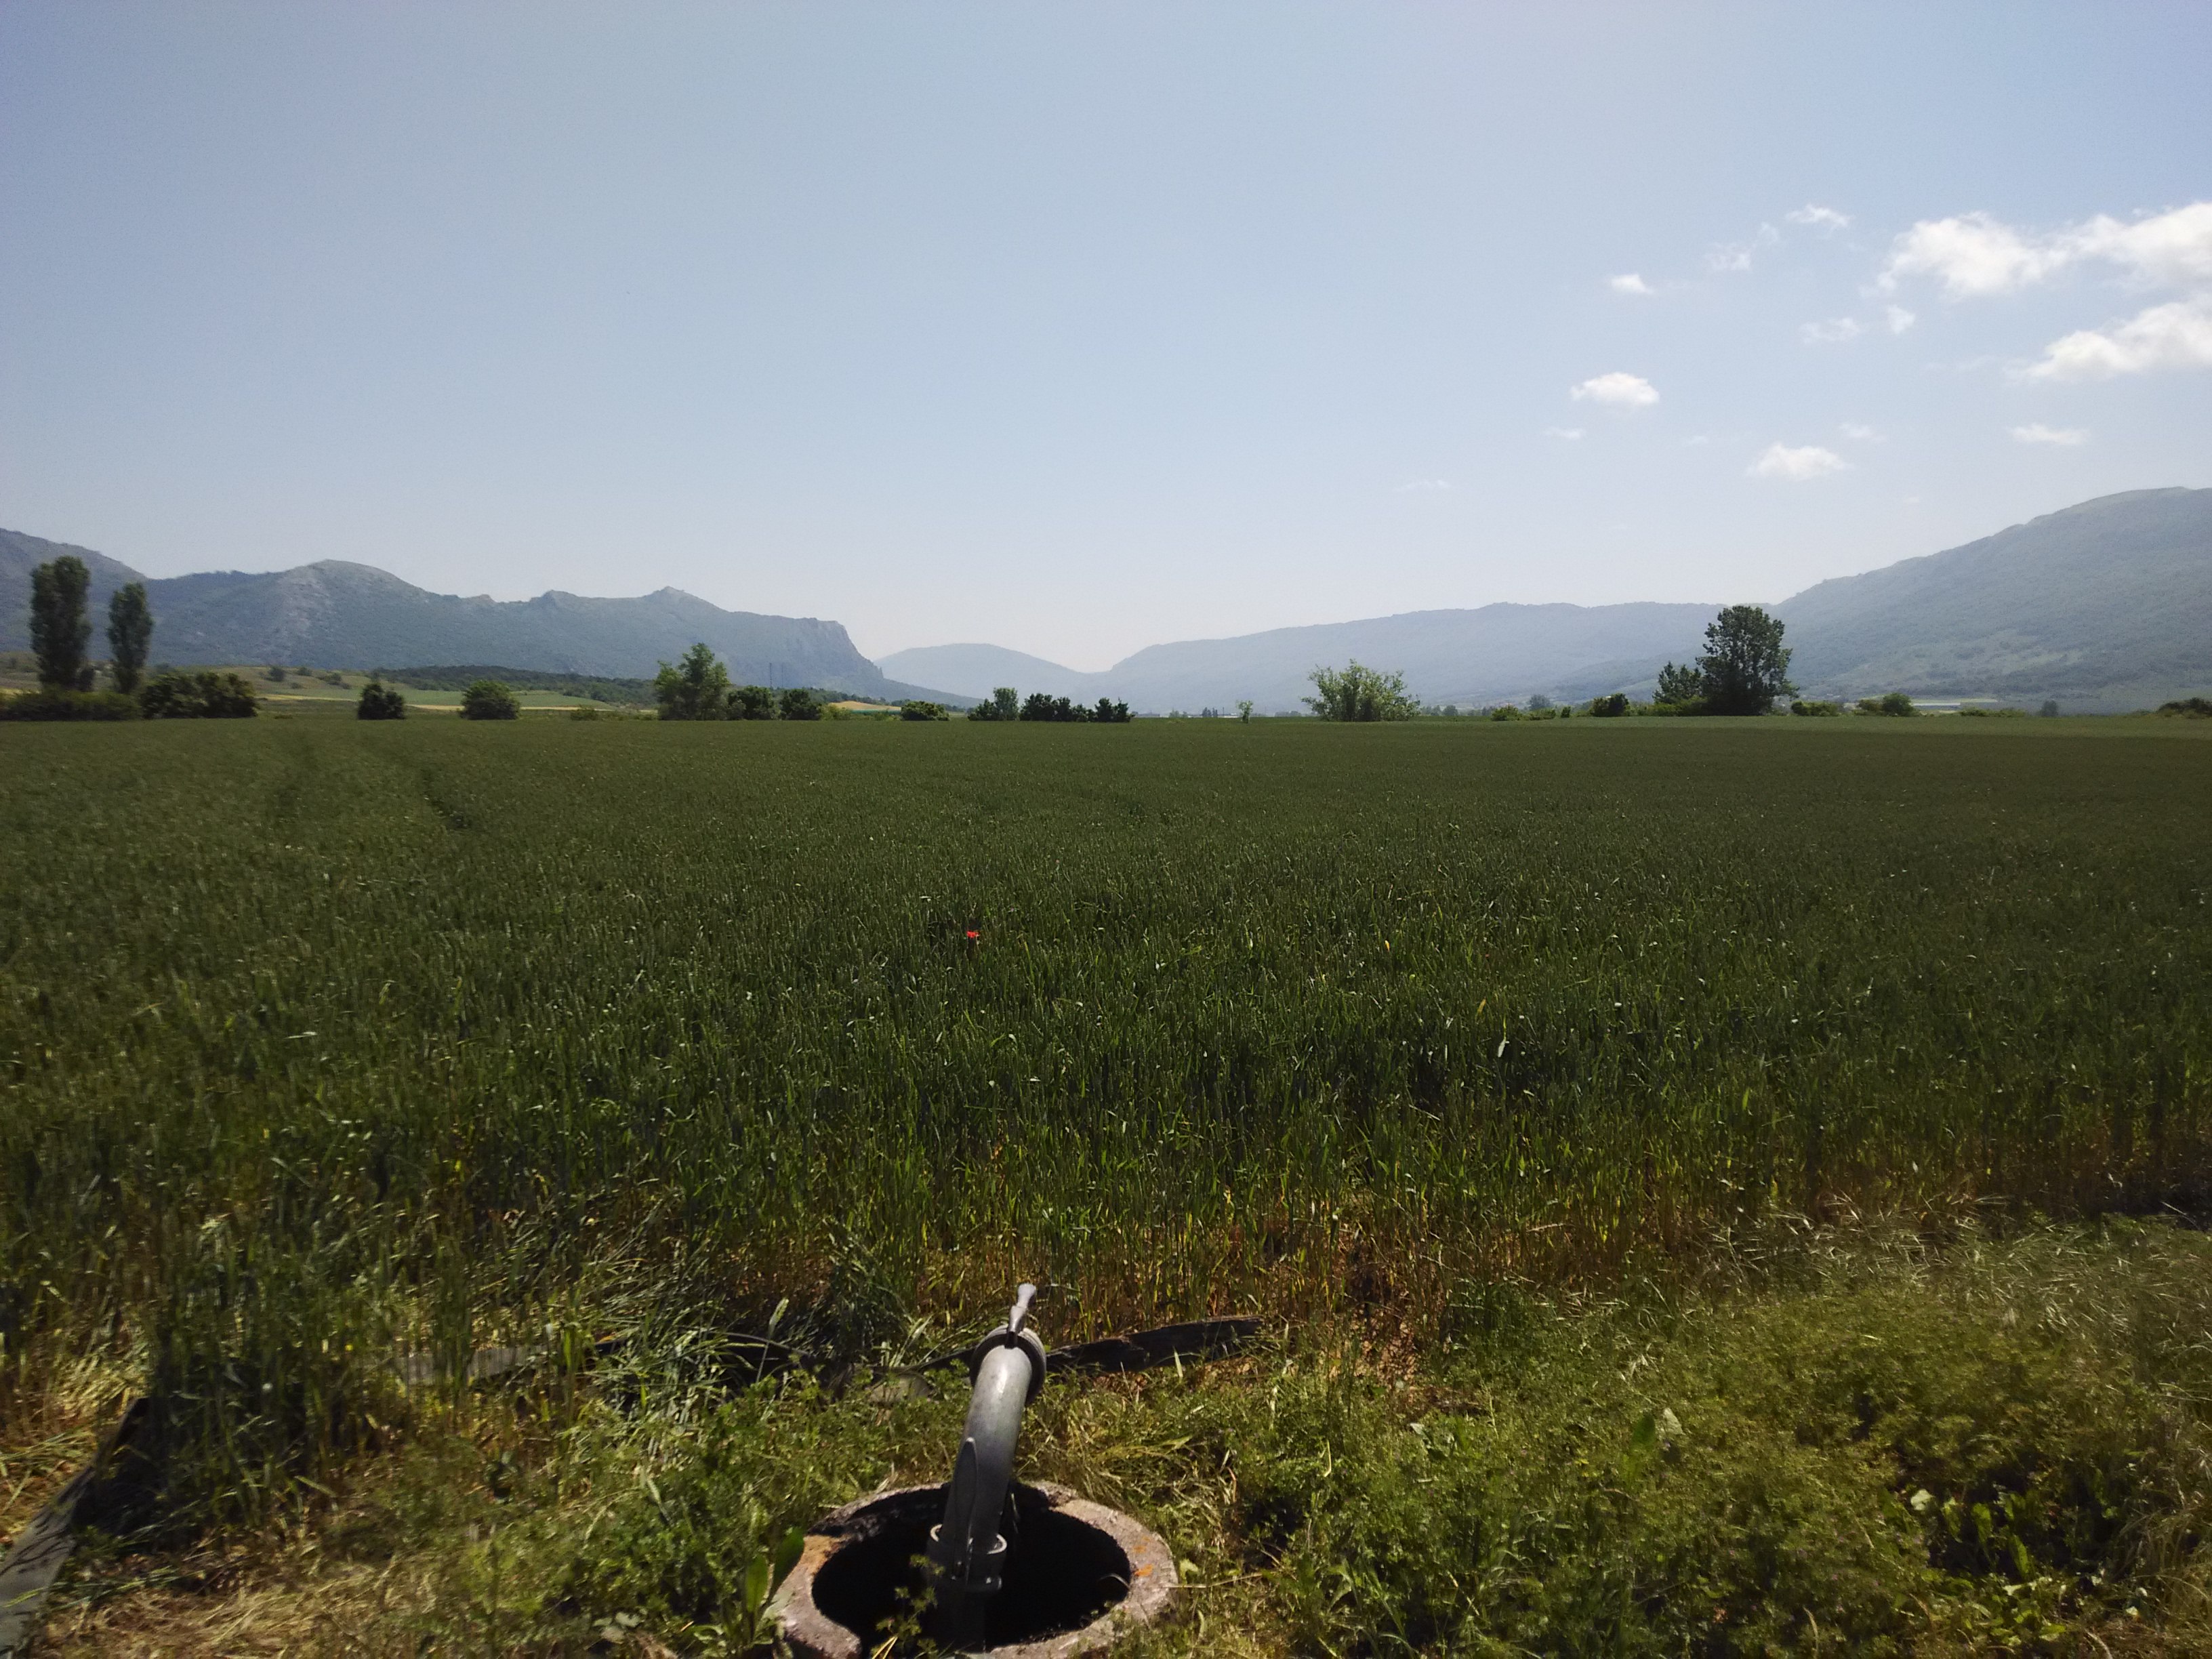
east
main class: Cropland
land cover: Barley
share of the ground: > 75 %
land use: Agriculture (excluding fallow land and kitchen gardens)
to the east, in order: Barley; Grass margins; Tracks; Grass margins; Common wheat
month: June
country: ES
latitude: 42.8801
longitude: -2.3518
